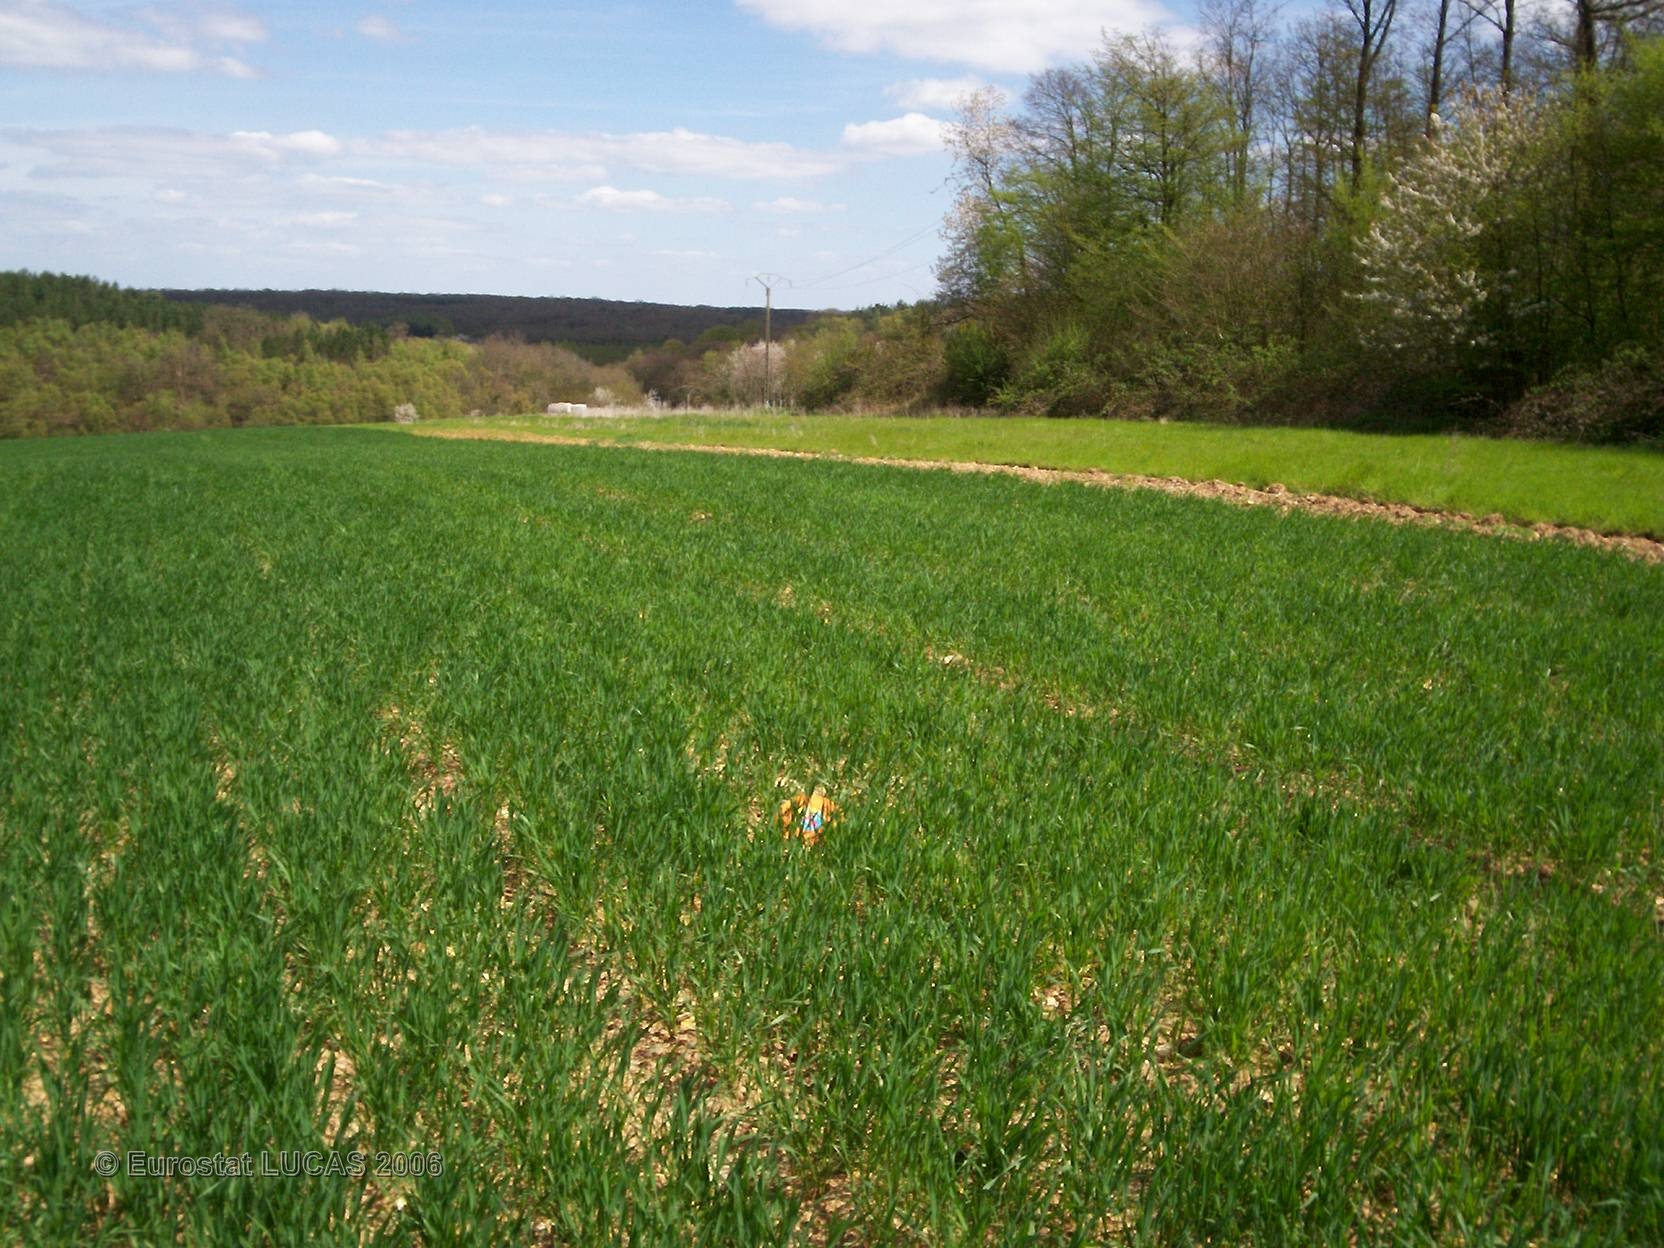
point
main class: Cropland
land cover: Common wheat
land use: Agriculture (excluding fallow land and kitchen gardens)
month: April
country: FR
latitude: 48.9438
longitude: 1.0358
